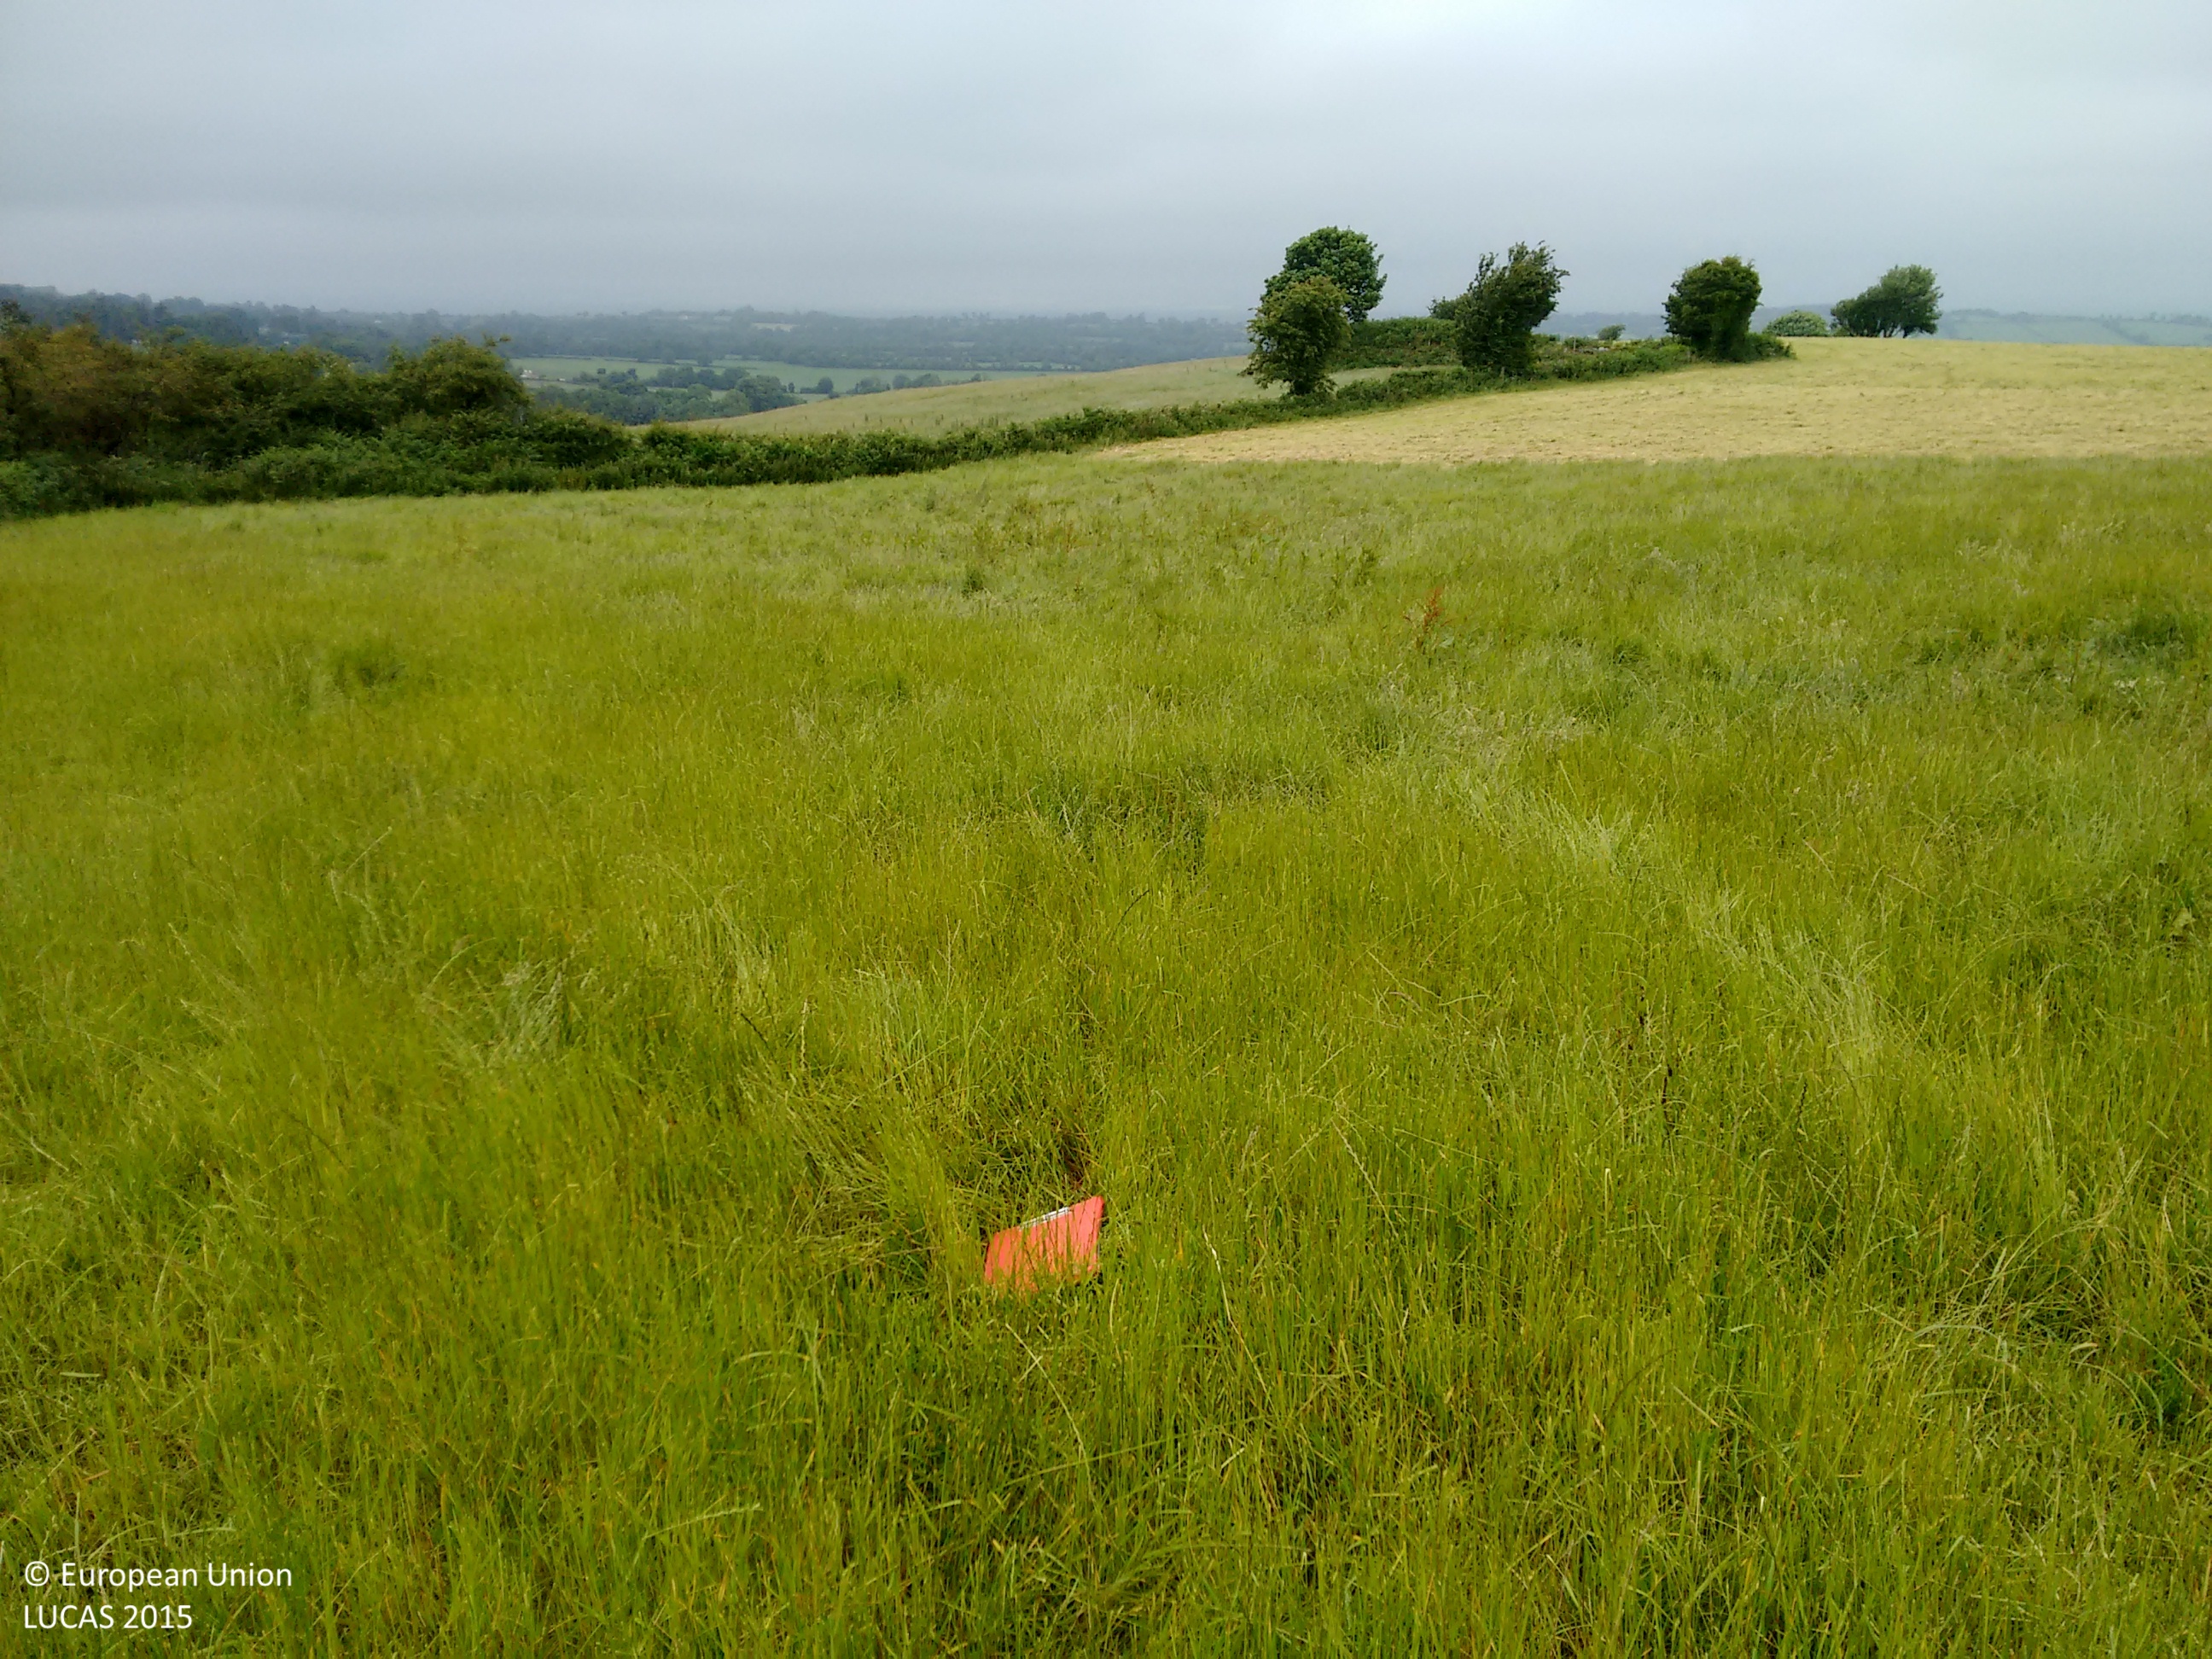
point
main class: Grassland
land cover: Grassland without tree/shrub cover
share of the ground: > 75 %
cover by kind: herbaceous plants 100 %
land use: Agriculture (excluding fallow land and kitchen gardens)
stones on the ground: < 10 %
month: June
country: IE
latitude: 52.4607
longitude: -7.3897
